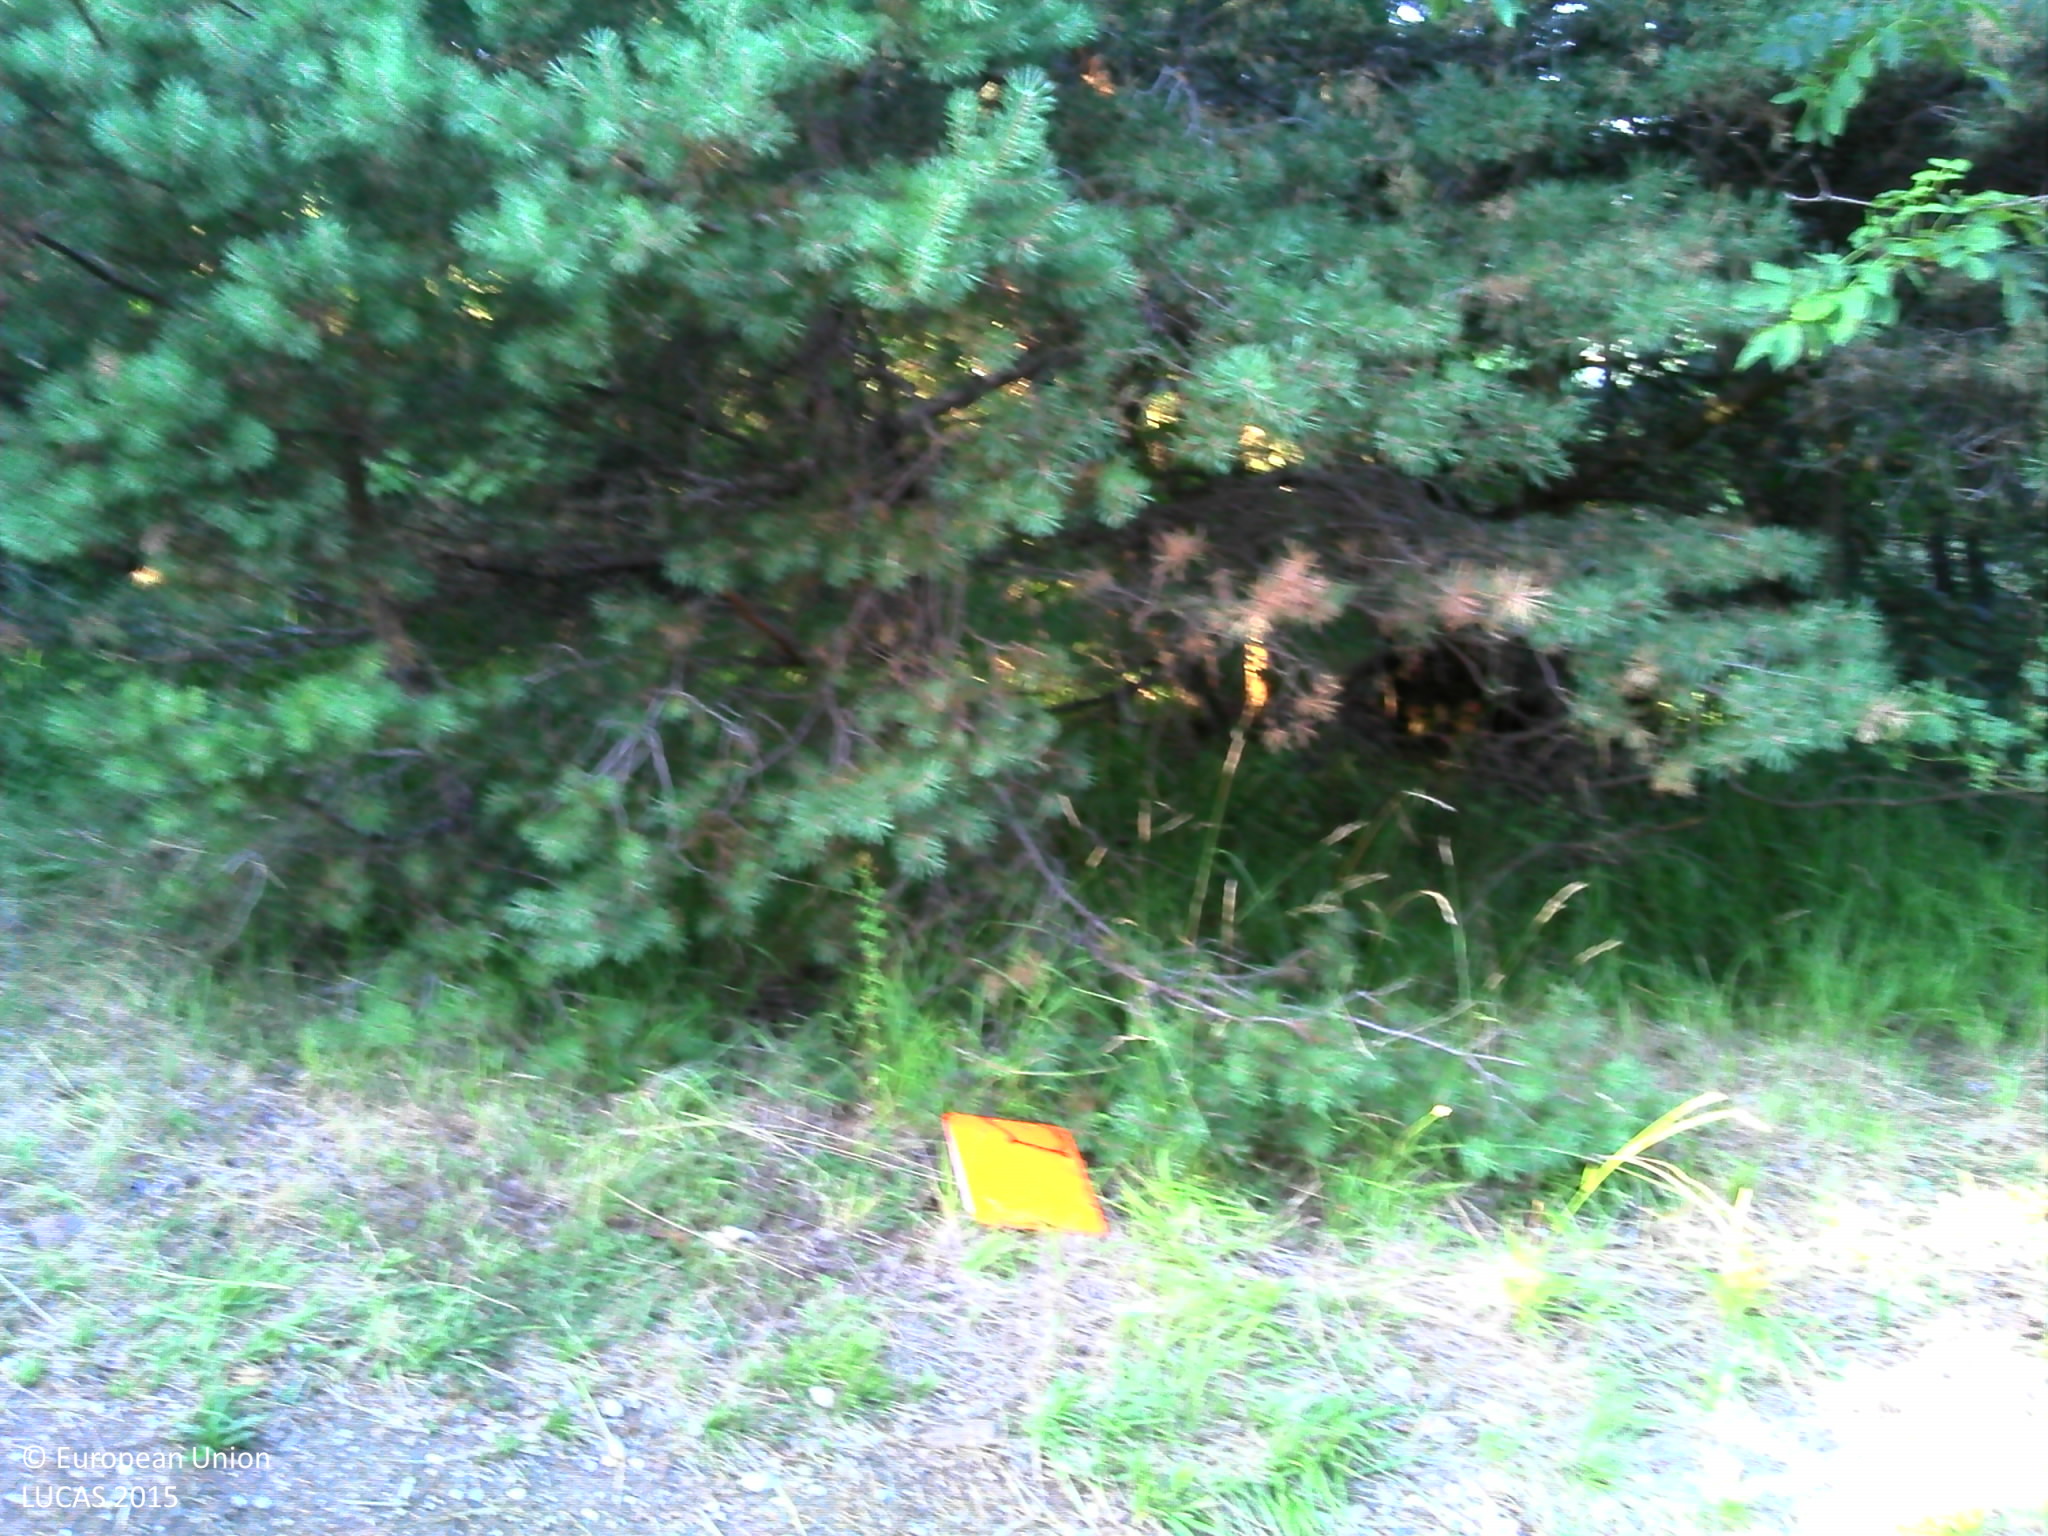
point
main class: Woodland
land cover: Pine dominated mixed woodland
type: hemiboreal forest and nemoral coniferous forest and mixed broadleaved-coniferous forest
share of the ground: > 75 %
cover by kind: herbaceous plants 60 %, coniferous forest trees 20 %, broadleaved forest trees 15 %, lichens and mosses 5 %
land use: Semi-natural and natural areas not in use
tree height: > 5 m
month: August
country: FR
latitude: 45.4164
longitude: 4.5220
